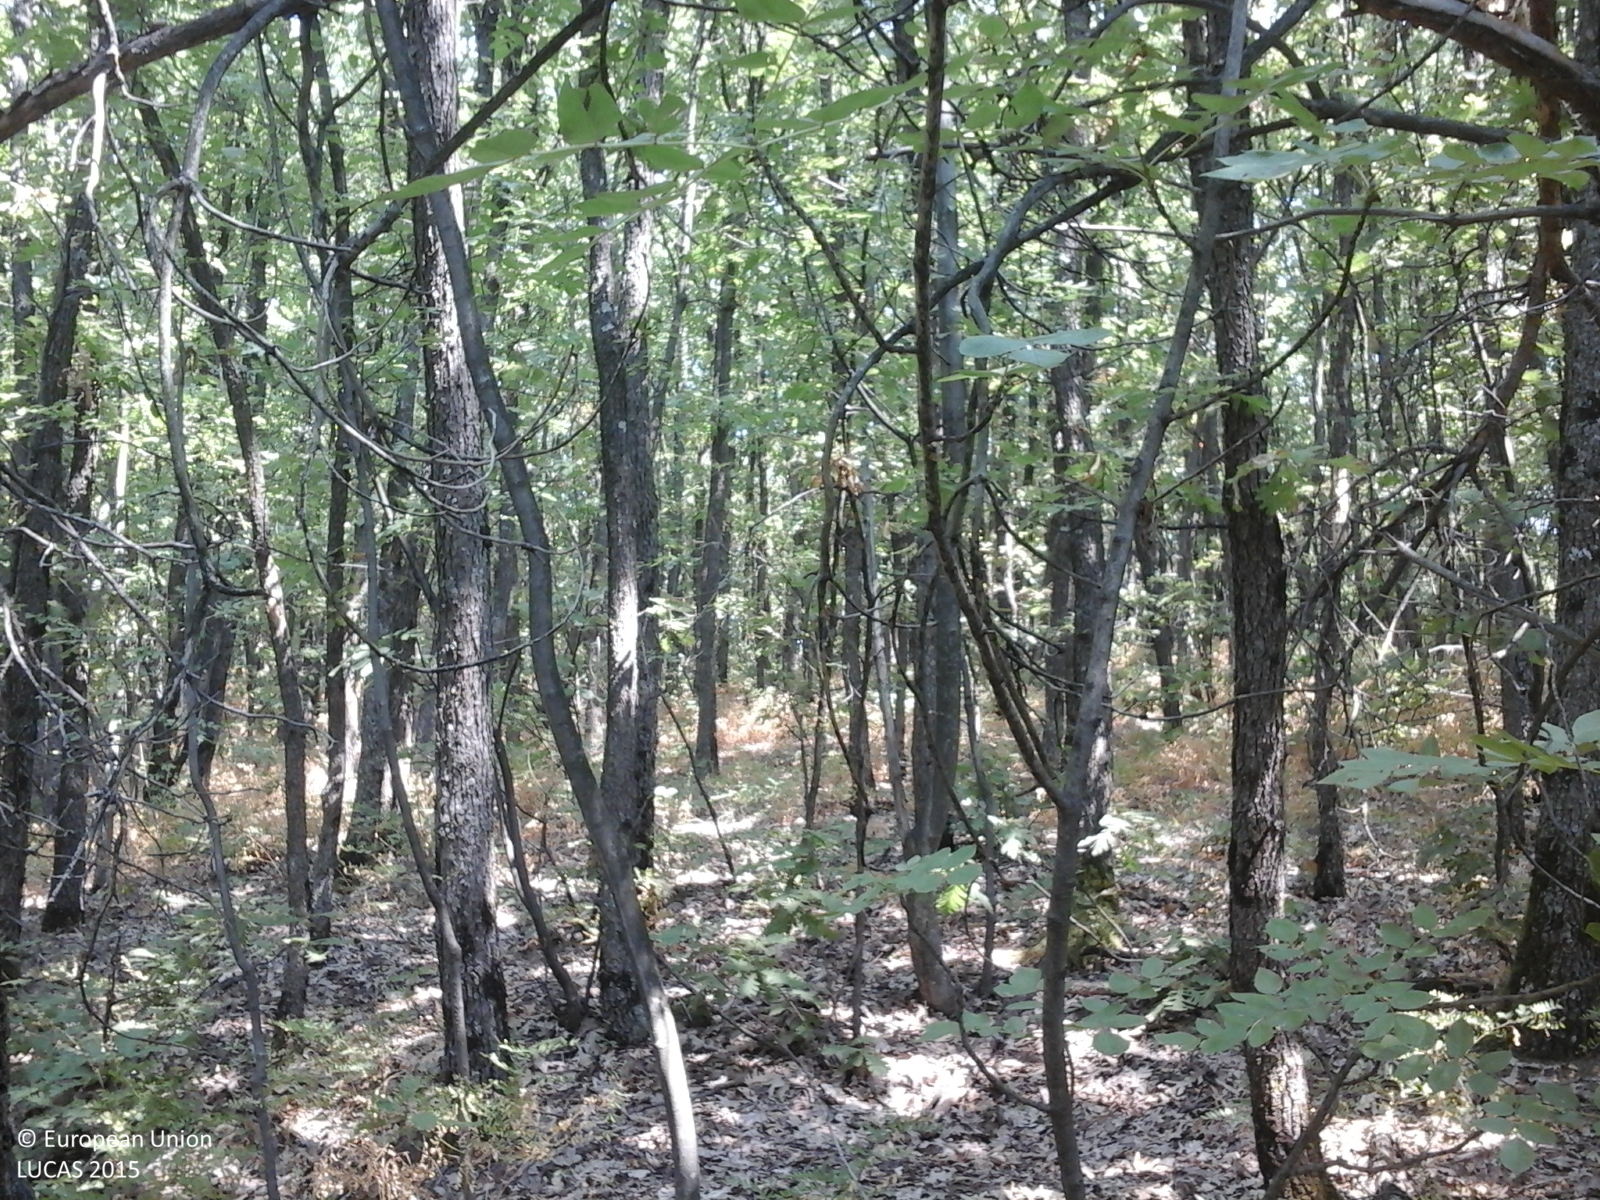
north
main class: Woodland
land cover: Broadleaved woodland
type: acidophilous oak and oak-birch forest
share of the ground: > 75 %
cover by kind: broadleaved forest trees 100 %
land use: Forestry
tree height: > 5 m
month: August
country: RO
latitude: 44.6380
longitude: 23.7367
